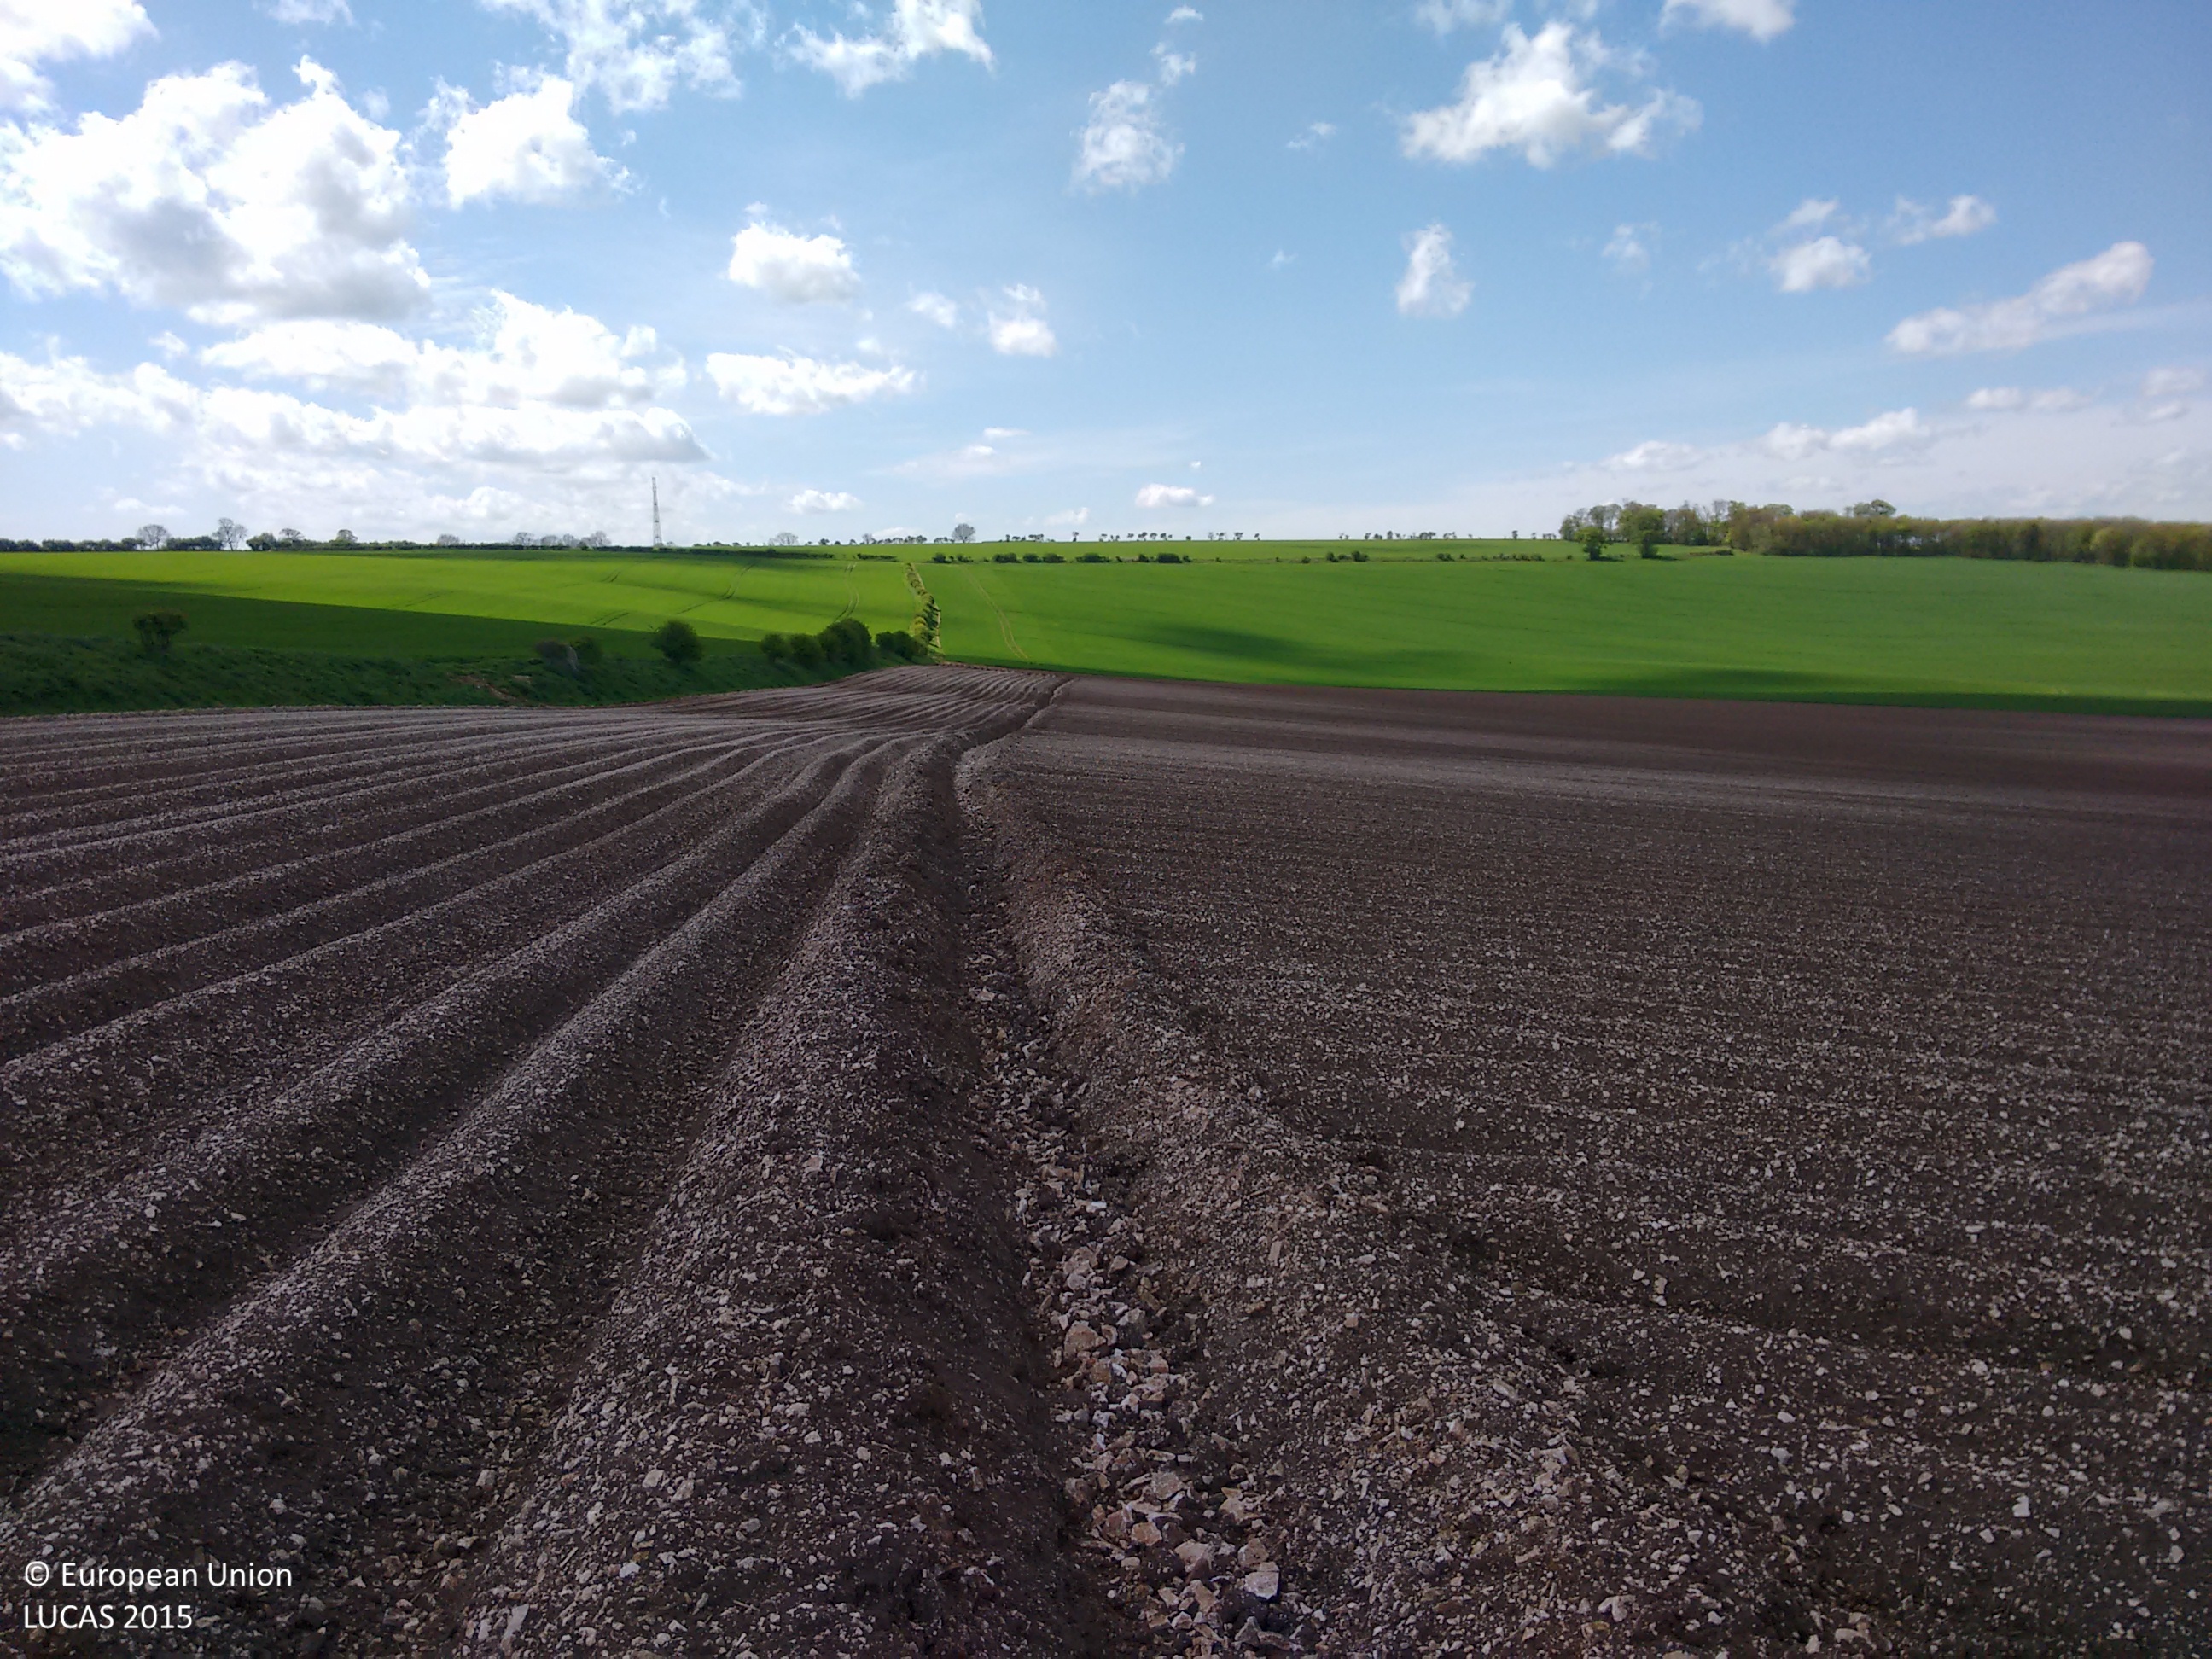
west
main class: Cropland
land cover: Potatoes
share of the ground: < 10 %
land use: Agriculture (excluding fallow land and kitchen gardens)
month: May
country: GB
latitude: 54.0863
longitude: -0.2918
